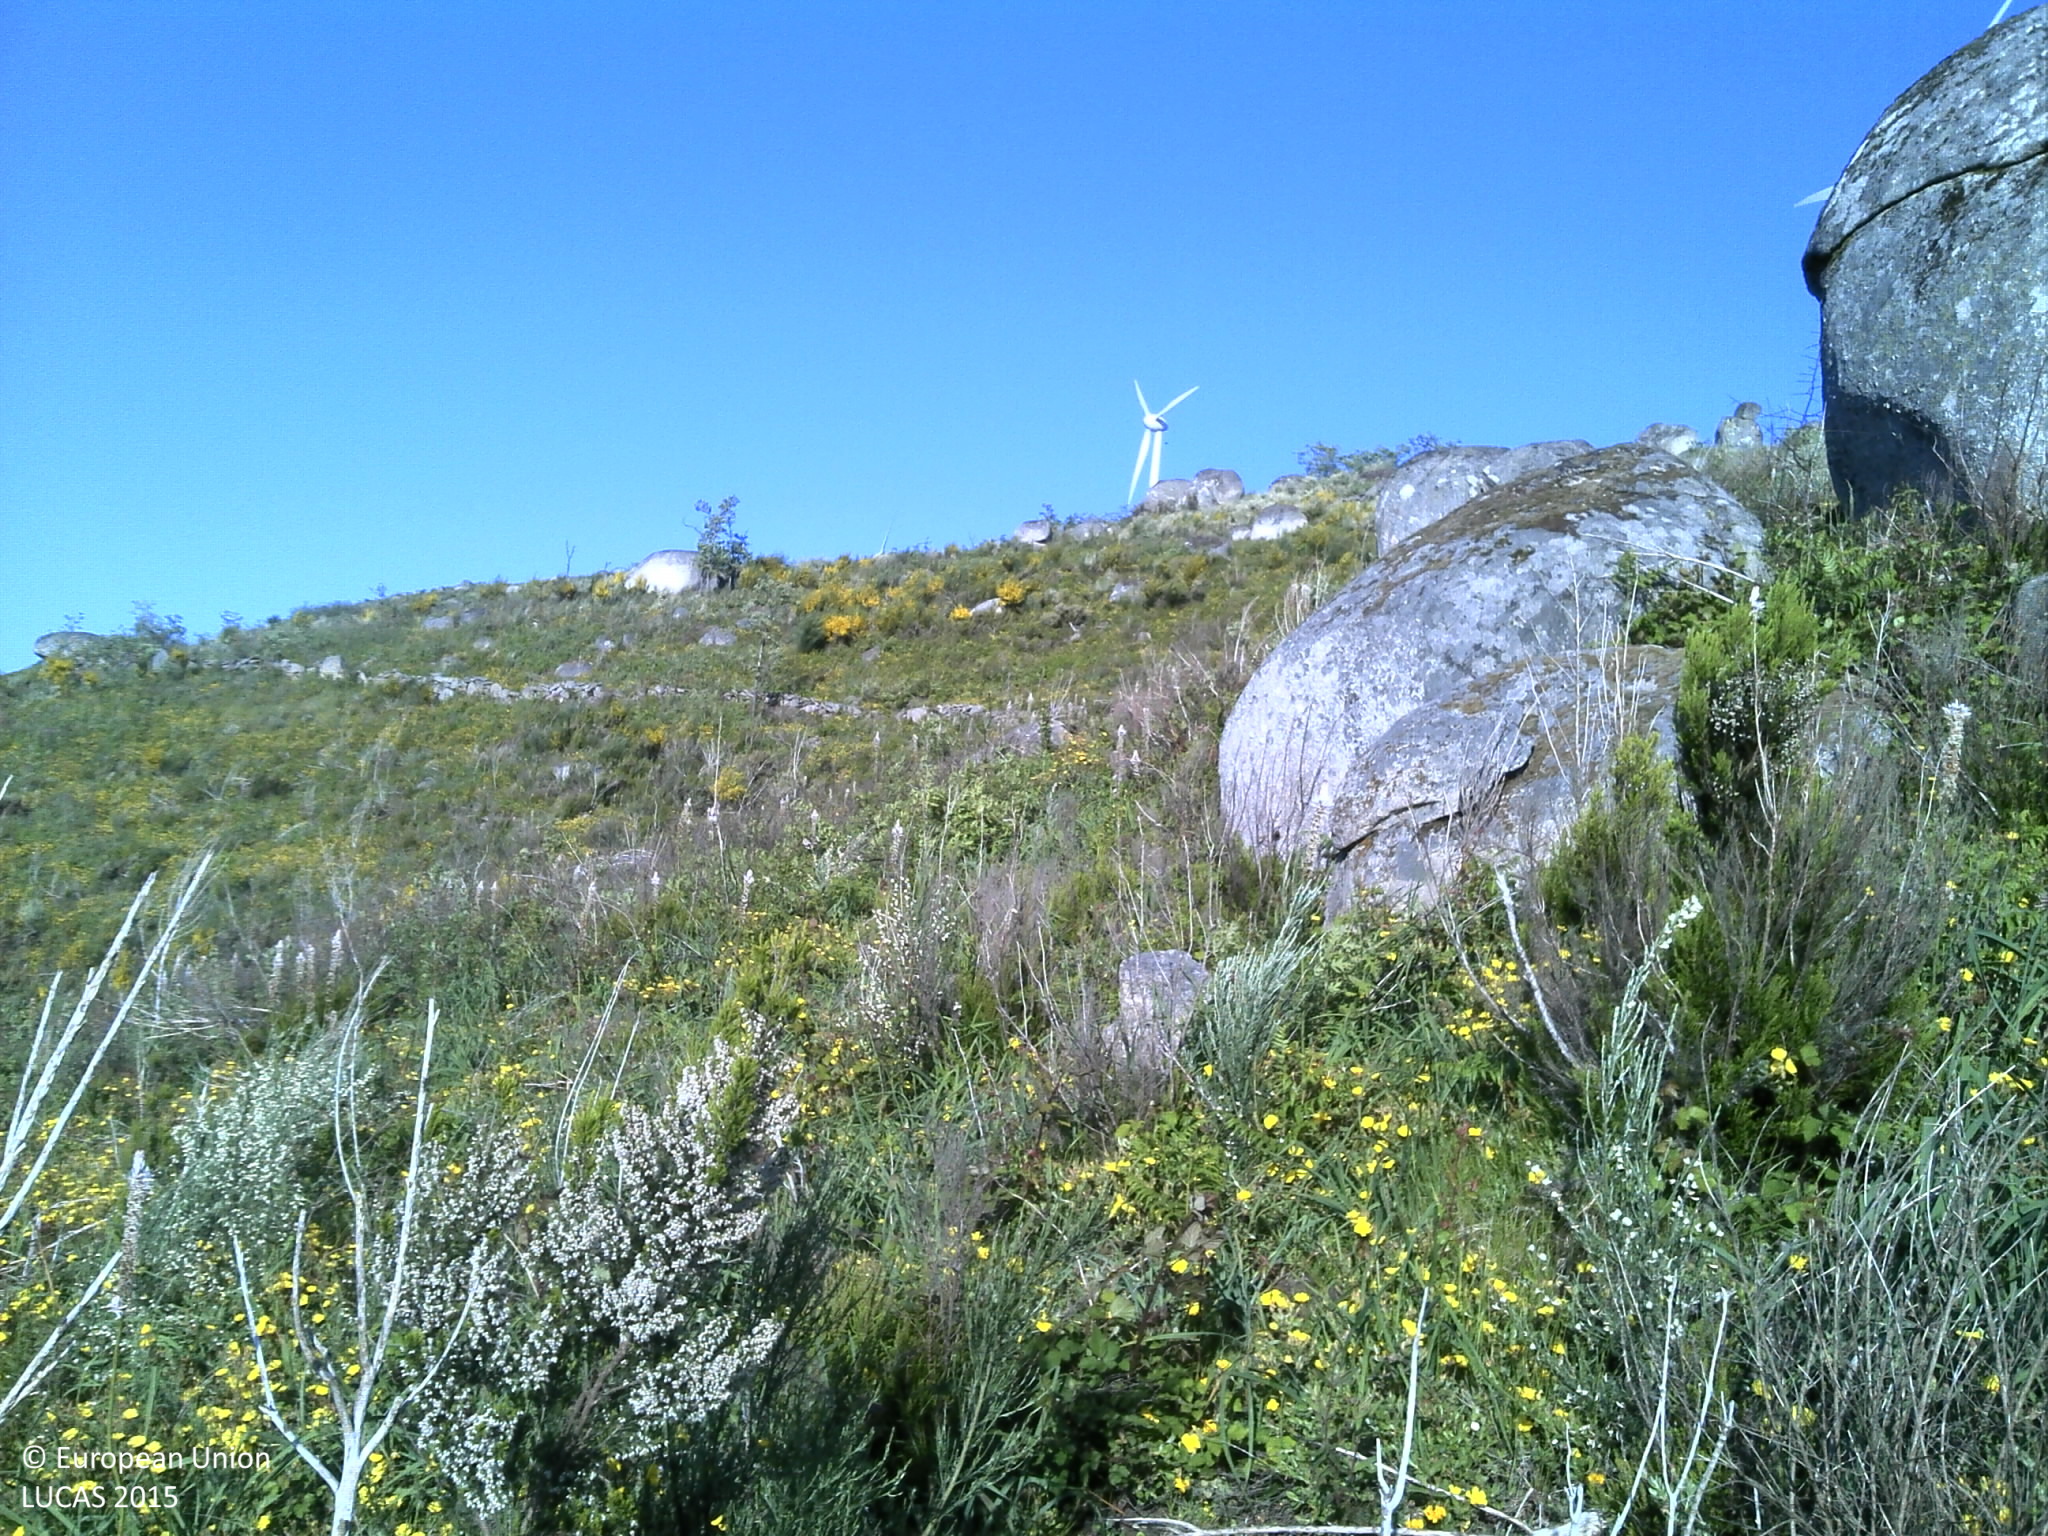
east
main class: Shrubland
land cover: Shrubland without tree cover
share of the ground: > 75 %
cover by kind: shrubs 80 %, unconsolidated bare surface 15 %, herbaceous plants 5 %
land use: Agriculture (excluding fallow land and kitchen gardens)
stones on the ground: < 10 %
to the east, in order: Shrubland without tree cover; Rock outcrops; Shrubland without tree cover; Electric lines; Shrubland without tree cover; Rivers and streams; Shrubland without tree cover; Dry stone walls; Shrubland without tree cover; Dry stone walls; Shrubland without tree cover; Rock outcrops; Shrubland without tree cover; Grass margins; Tracks; Grass margins
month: May
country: PT
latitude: 41.0334
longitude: -8.1576
